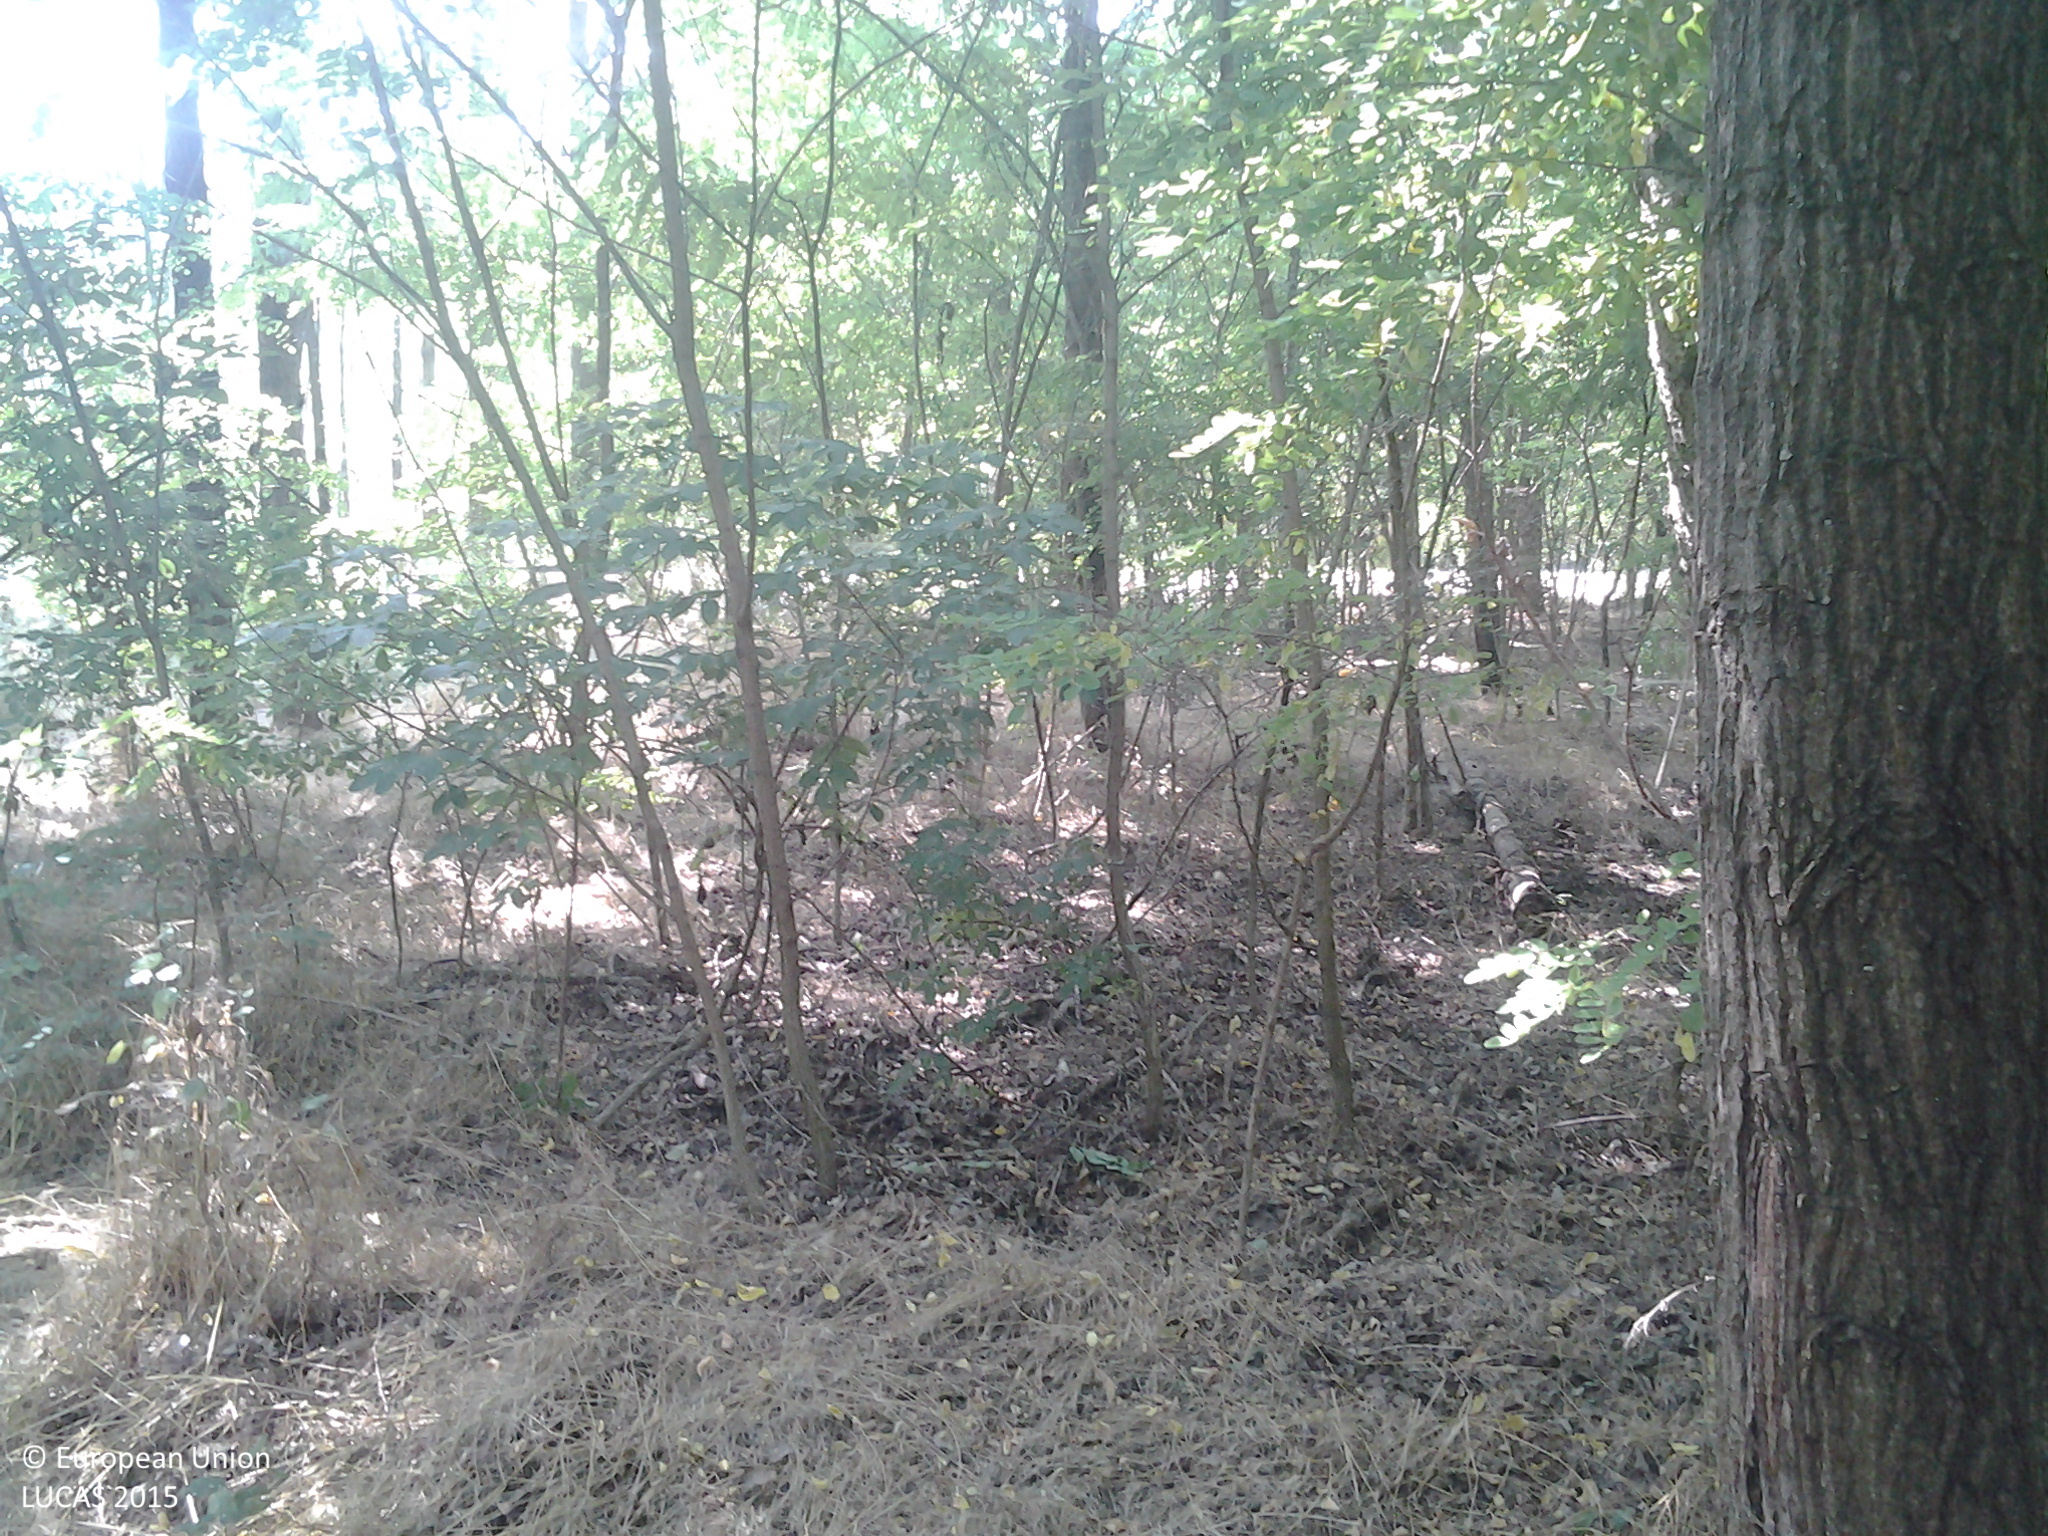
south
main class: Woodland
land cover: Broadleaved woodland
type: exotic forest
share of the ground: 50 - 75 %
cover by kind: broadleaved forest trees 70 %, herbaceous plants 30 %
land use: Forestry
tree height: > 5 m
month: July
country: HU
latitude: 46.8767
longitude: 19.0030
